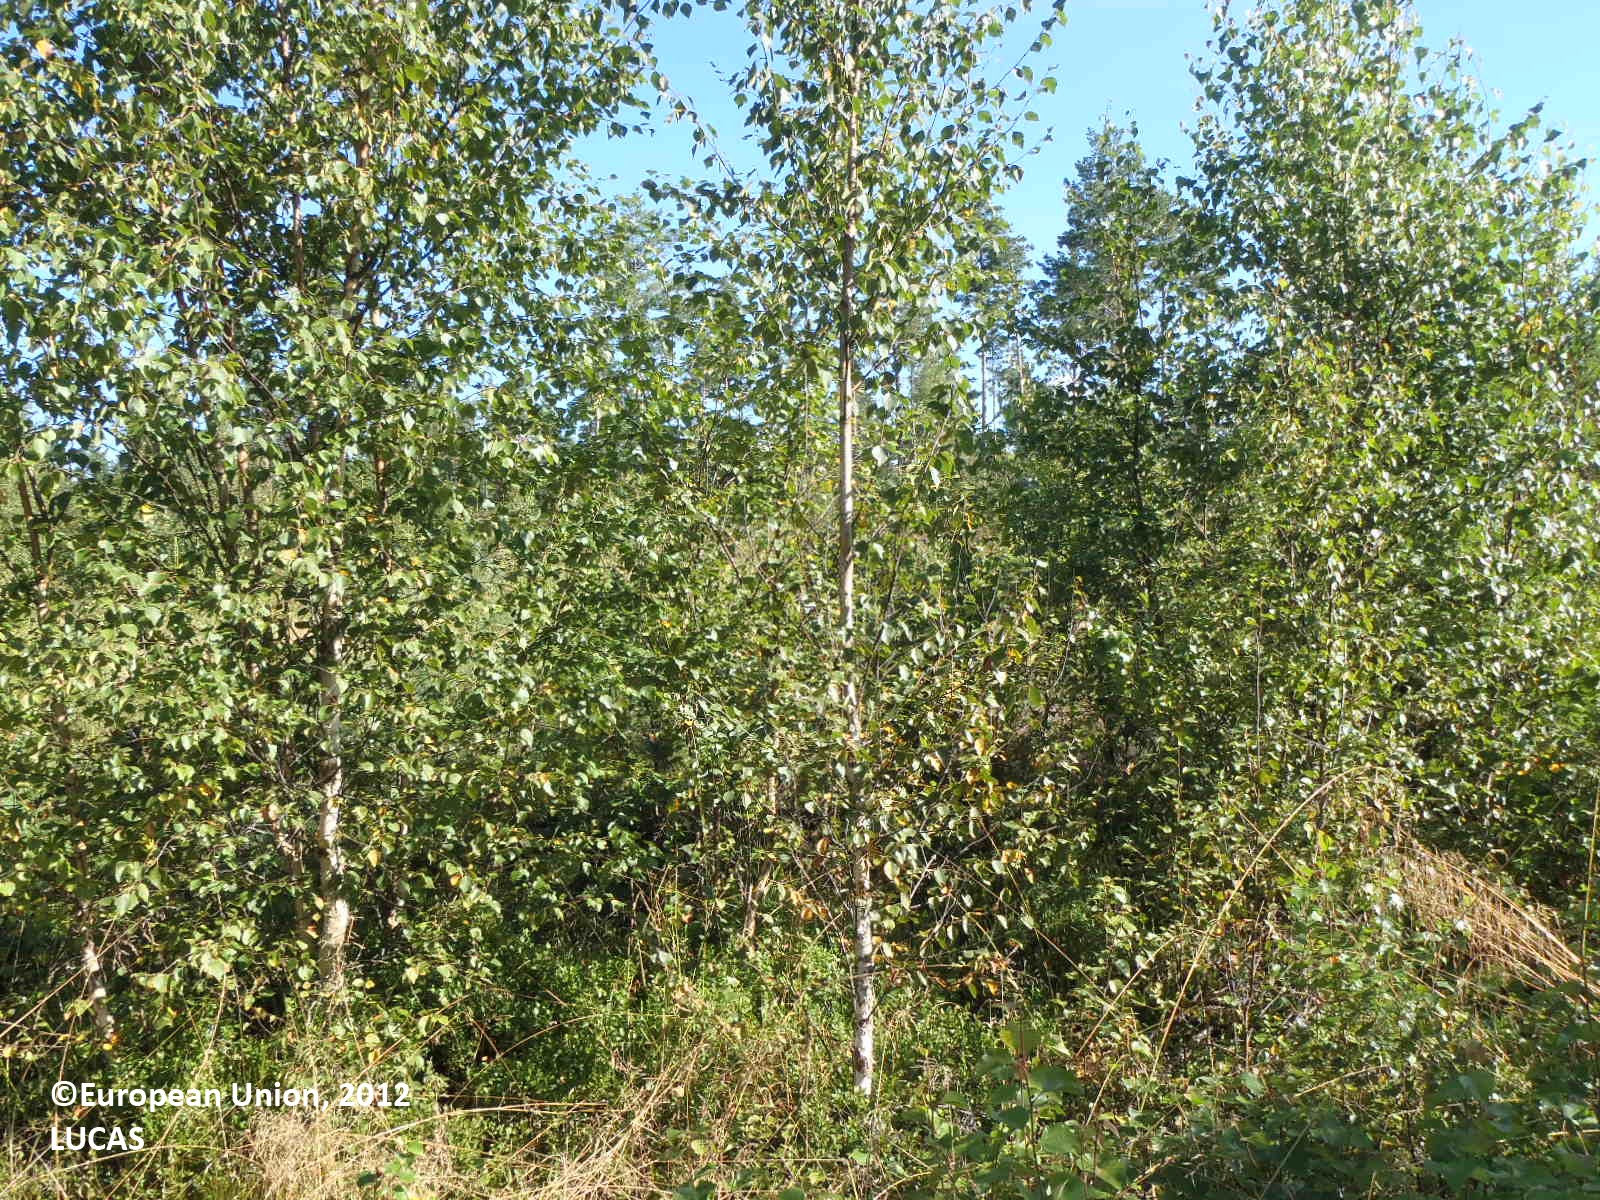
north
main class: Woodland
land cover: Spruce dominated mixed woodland
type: boreal forest
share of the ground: > 75 %
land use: Forestry
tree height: > 5 m
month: August
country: FI
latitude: 60.2455
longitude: 22.2616
